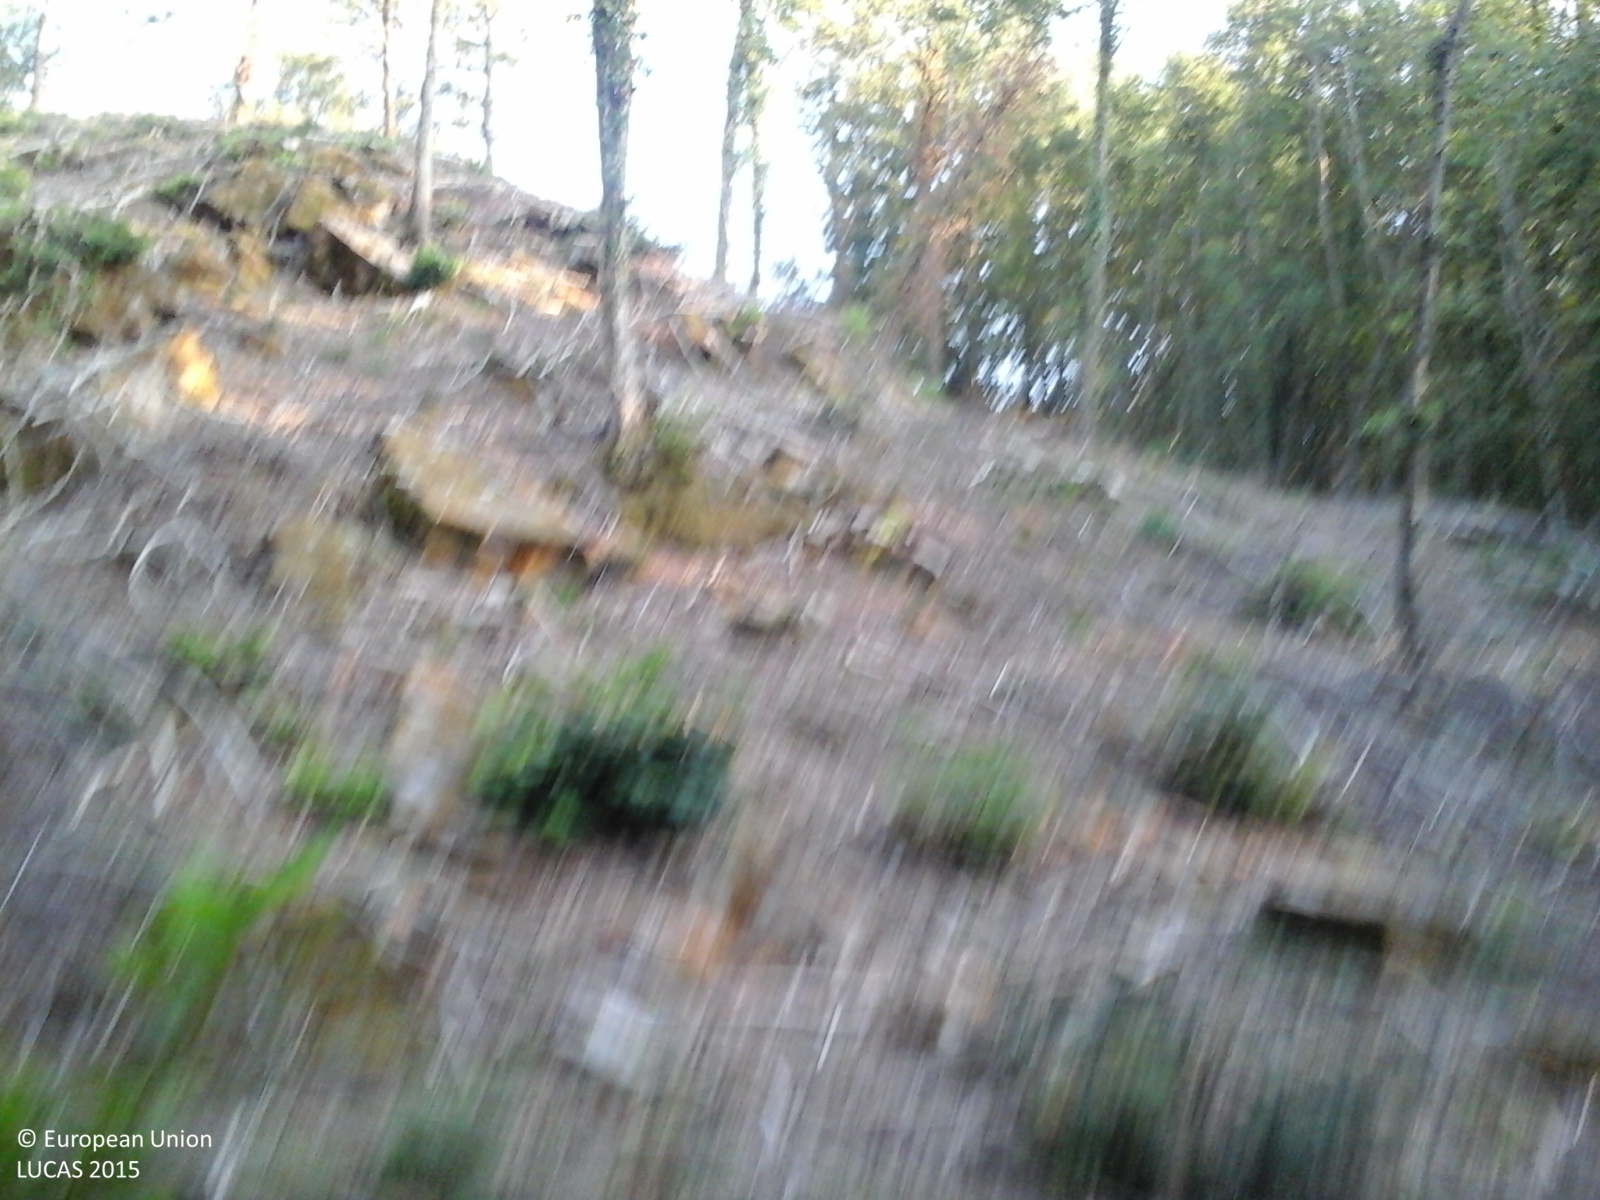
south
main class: Woodland
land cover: Broadleaved woodland
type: thermophilous deciduous forest
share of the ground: > 75 %
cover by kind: broadleaved forest trees 75 %, shrubs 20 %, herbaceous plants 5 %
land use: Forestry
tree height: > 5 m
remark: Clear cut
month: August
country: IT
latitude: 42.8040
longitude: 11.5967
